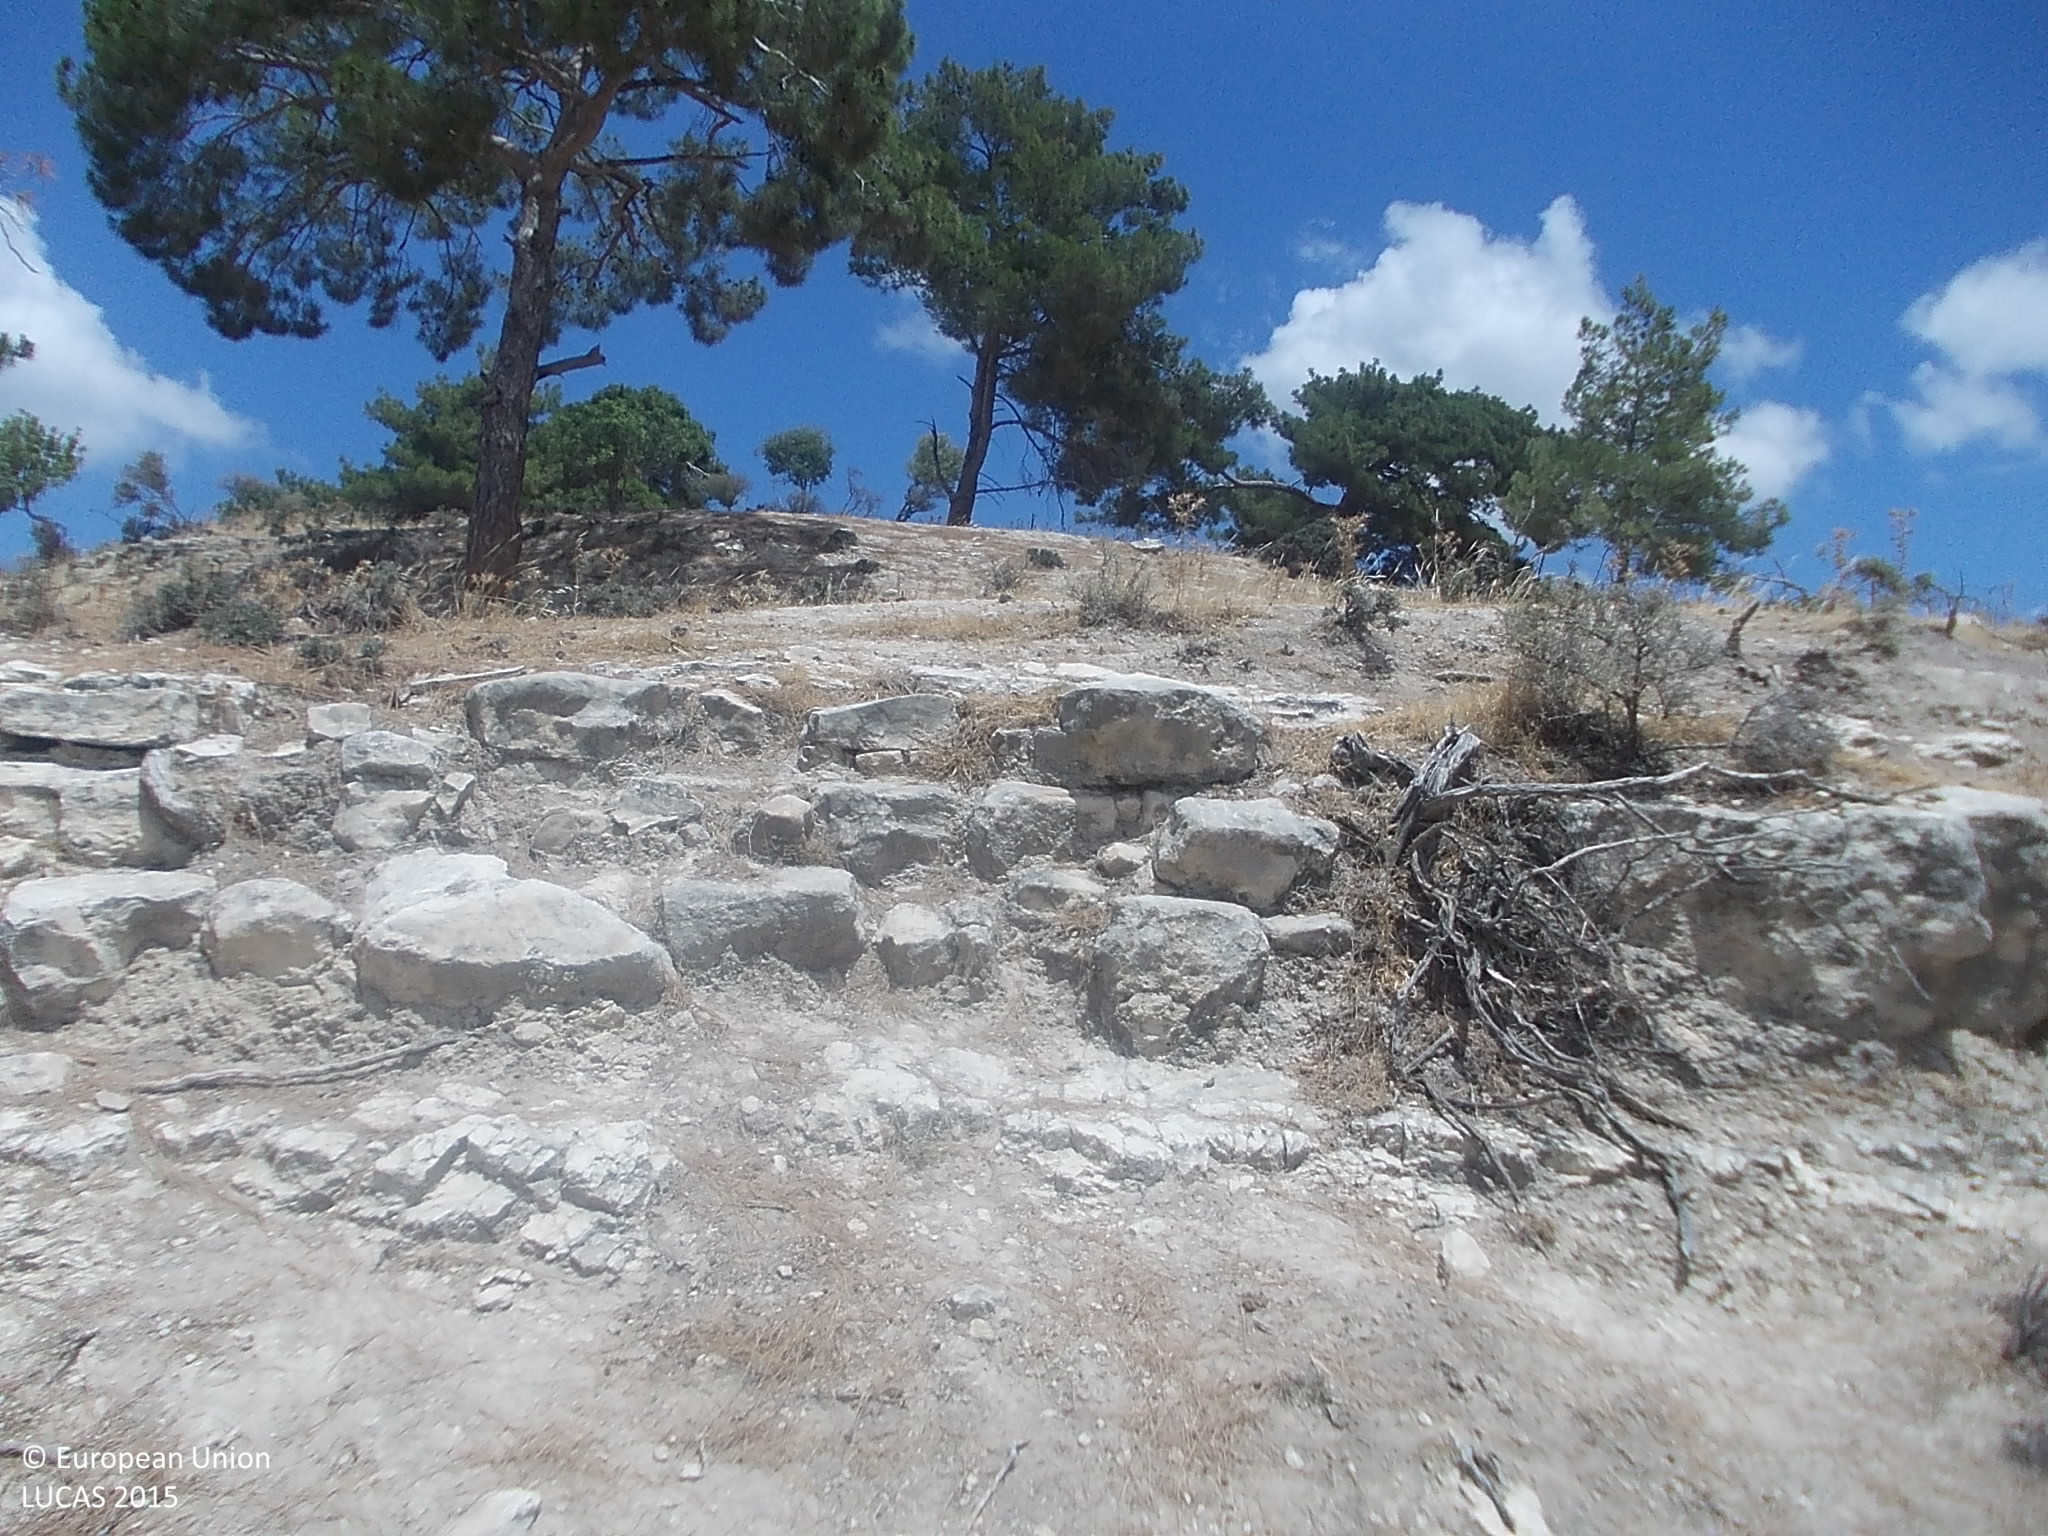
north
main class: Woodland
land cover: Pine dominated coniferous woodland
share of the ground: 25 - 50 %
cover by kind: coniferous forest trees 35 %, unconsolidated bare surface 30 %, consolidated bare surface 25 %, shrubs 5 %, herbaceous plants 5 %
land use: Semi-natural and natural areas not in use
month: June
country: CY
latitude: 34.7758
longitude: 32.9244
